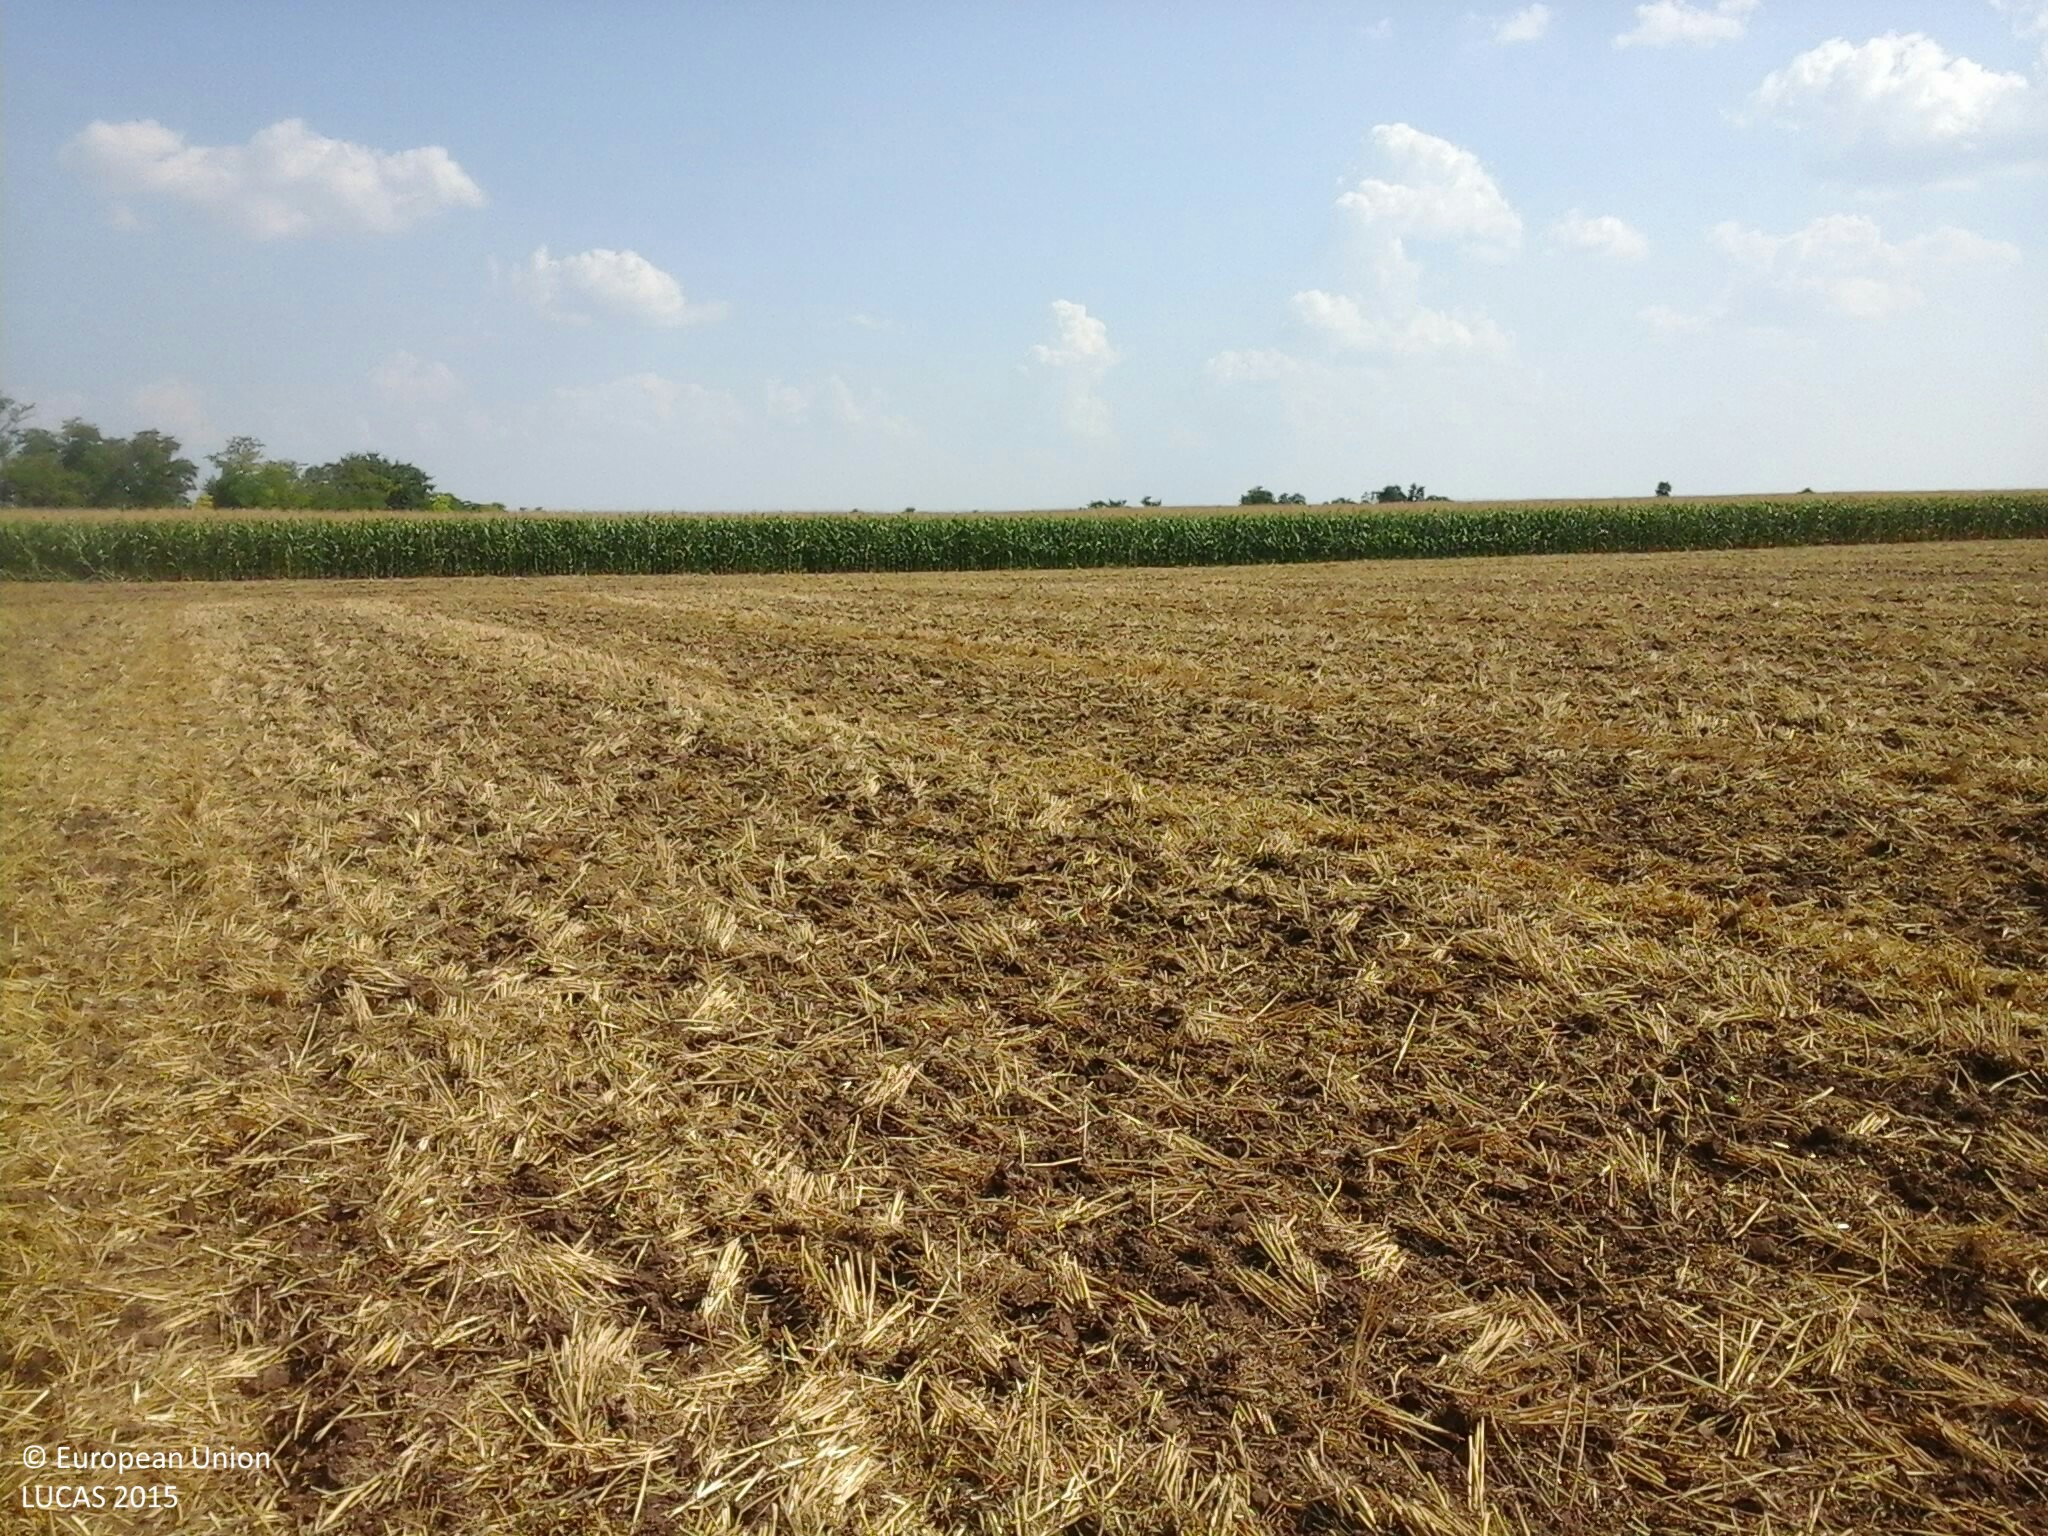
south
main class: Cropland
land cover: Common wheat
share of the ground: < 10 %
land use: Agriculture (excluding fallow land and kitchen gardens)
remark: Harvested field
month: August
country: HU
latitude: 47.0048
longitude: 18.3101
